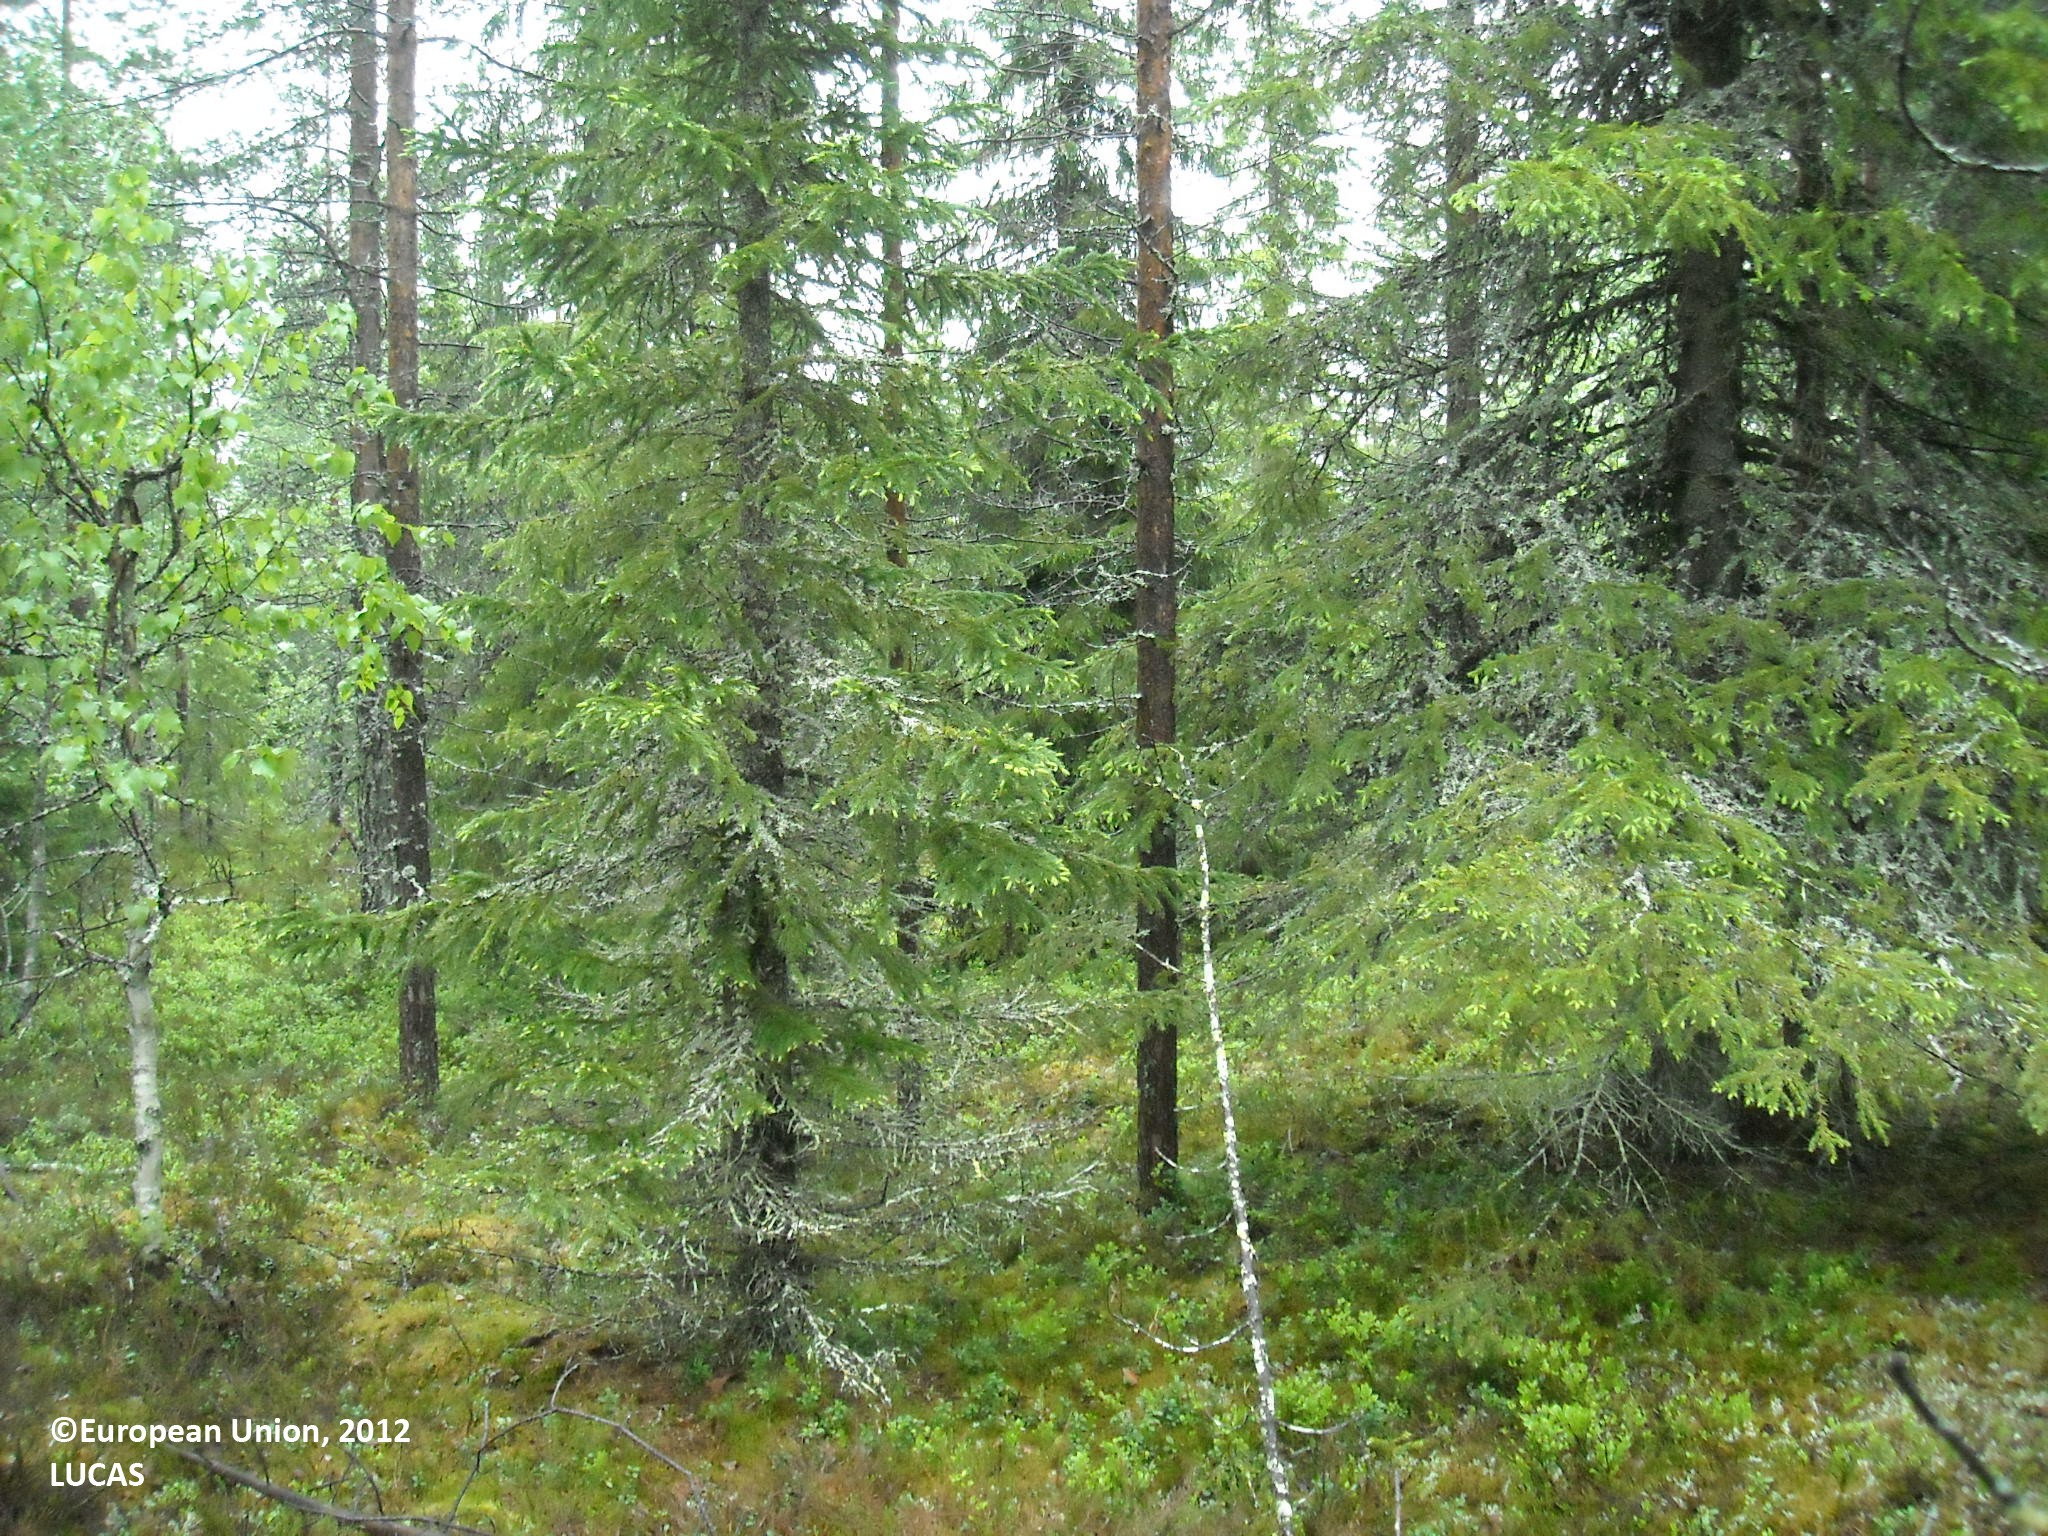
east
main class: Woodland
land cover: Other coniferous woodland
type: boreal forest
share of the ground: > 75 %
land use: Forestry
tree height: > 5 m
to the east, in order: Other coniferous woodland; Other mixed woodland; Pine dominated mixed woodland; Tracks; Other mixed woodland; Other coniferous woodland
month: June
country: FI
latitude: 65.6255
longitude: 27.8808
